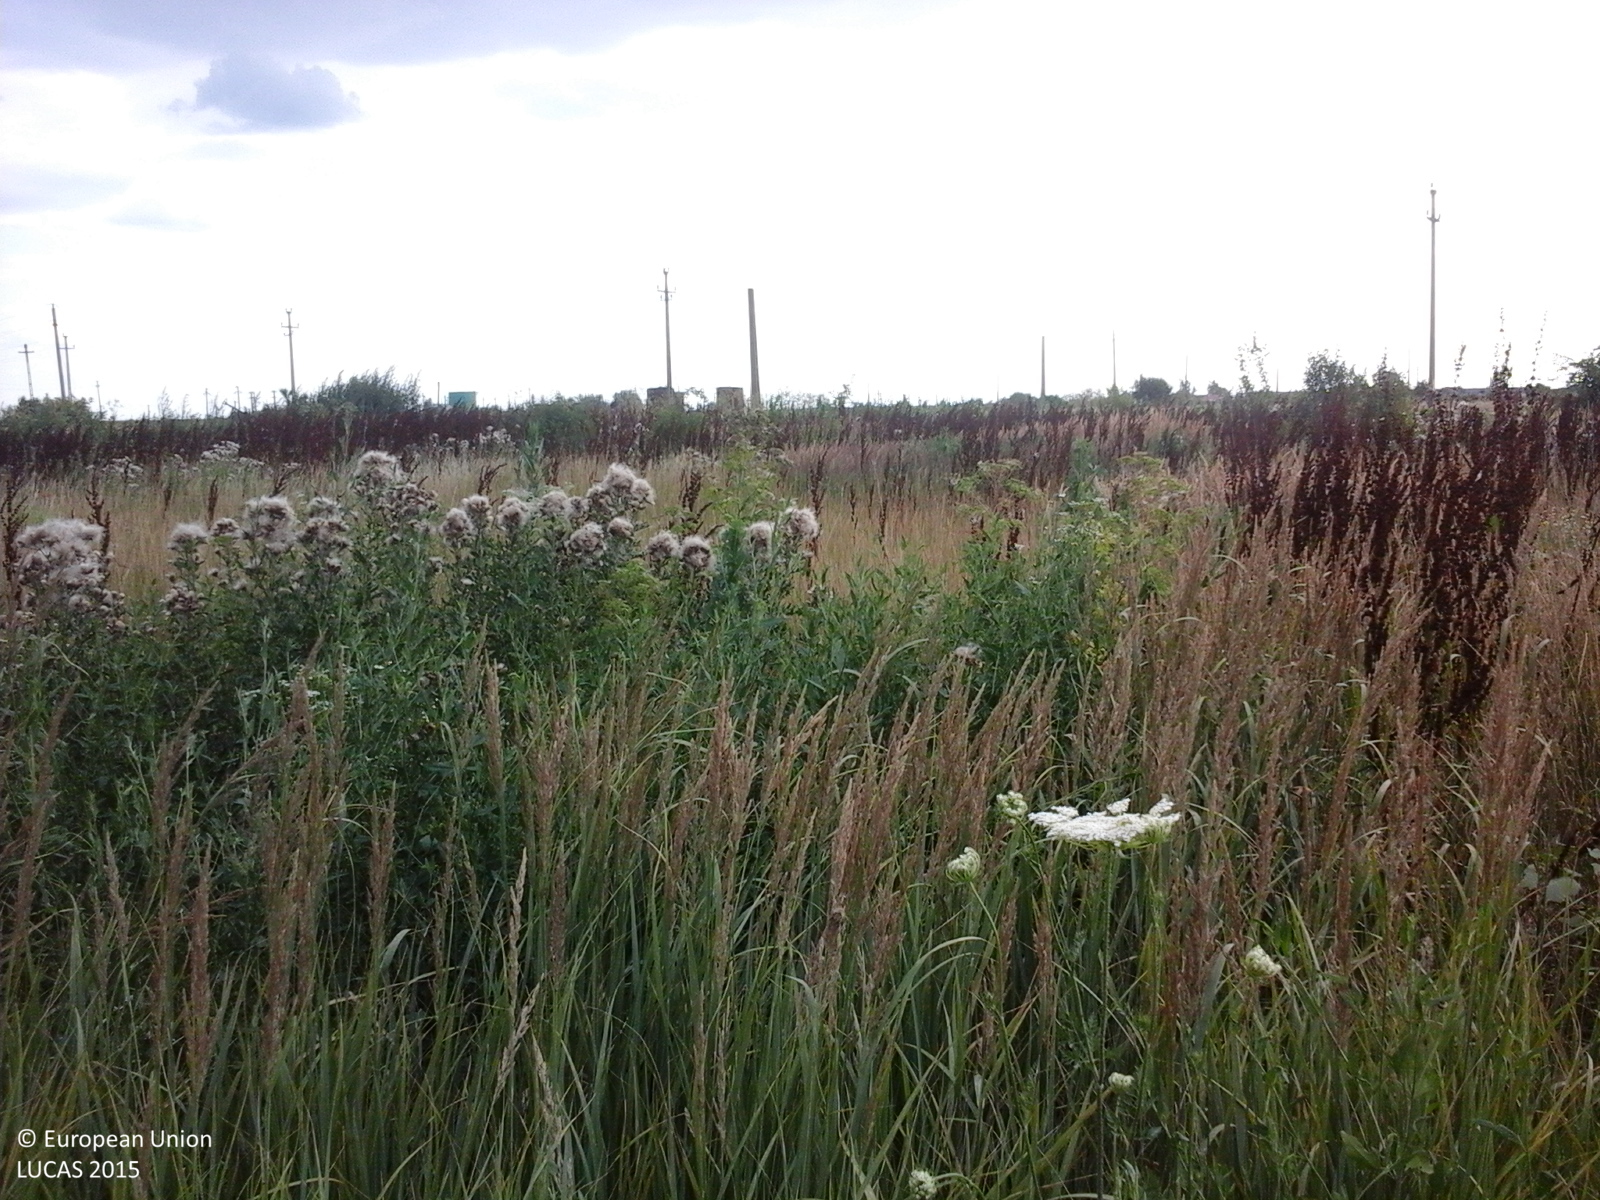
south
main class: Grassland
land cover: Spontaneously vegetated surfaces
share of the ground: > 75 %
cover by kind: herbaceous plants 100 %
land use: Fallow land
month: July
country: RO
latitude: 44.3156
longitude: 25.3704
